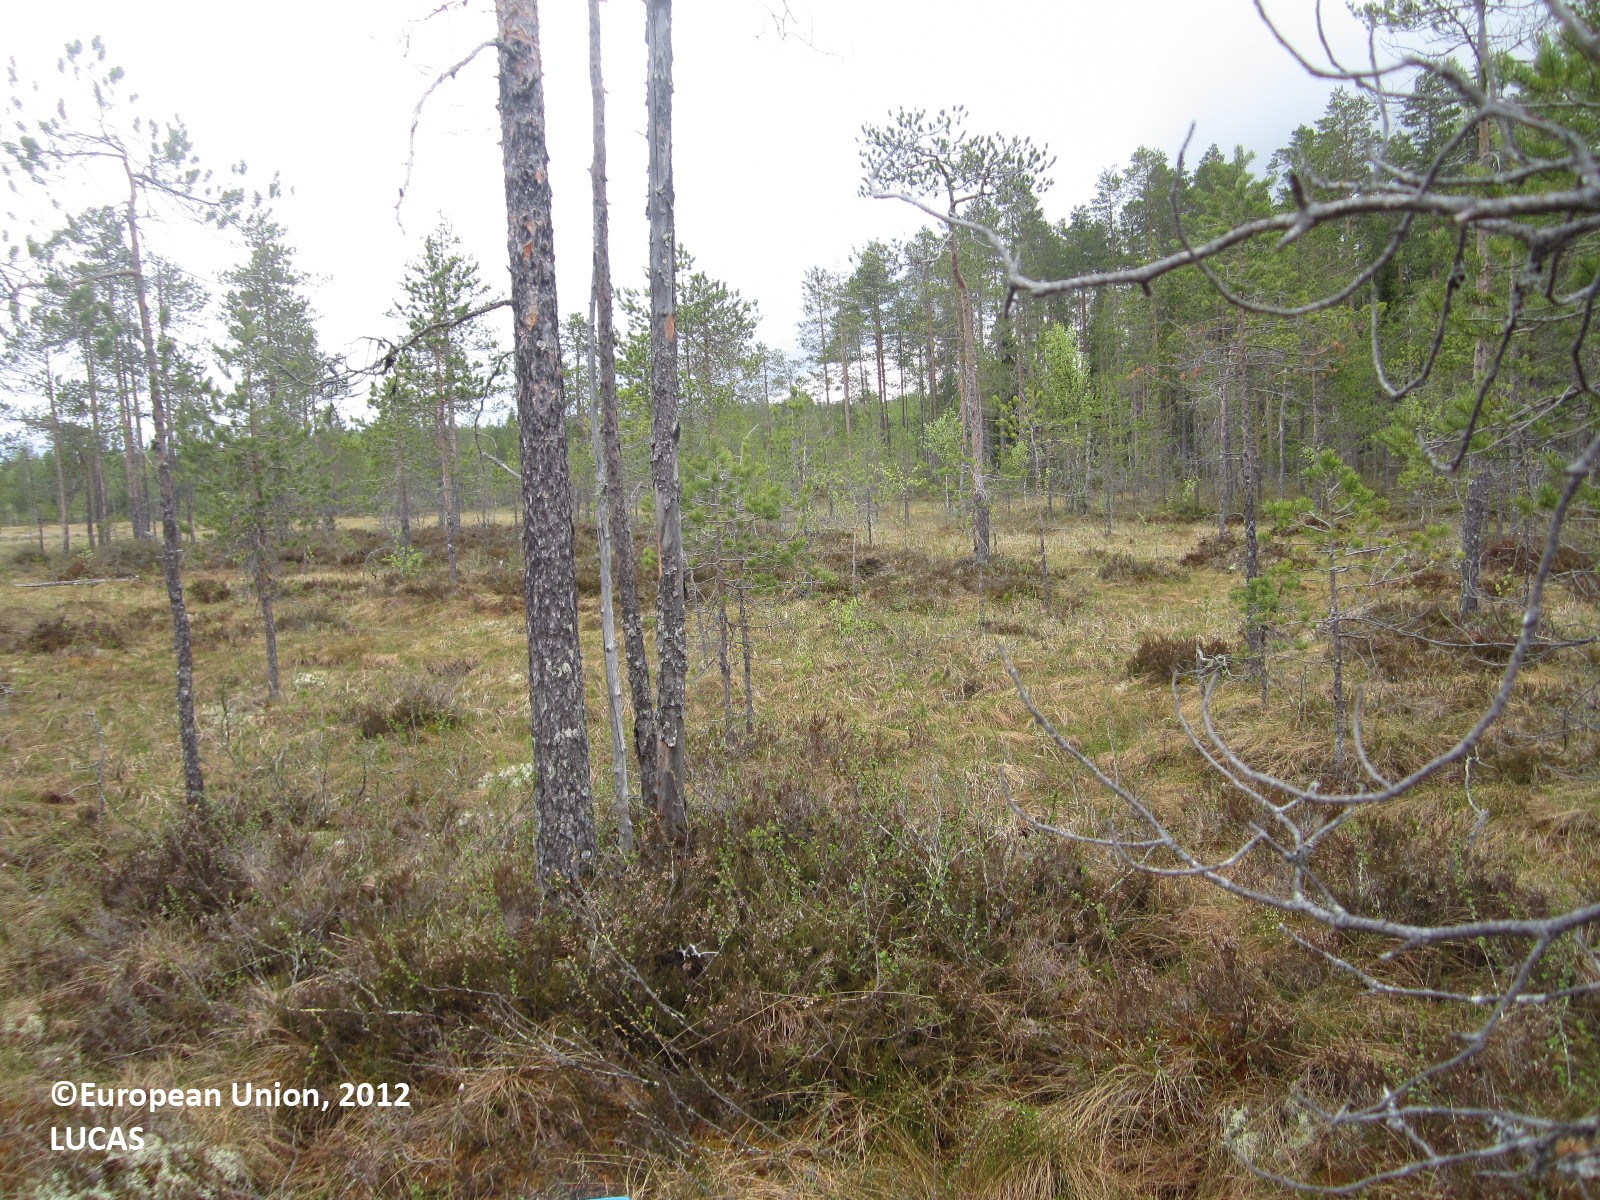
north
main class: Woodland
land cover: Pine dominated coniferous woodland
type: mire and swamp forests
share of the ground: 10 - 25 %
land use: Semi-natural and natural areas not in use
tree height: > 5 m
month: June
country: FI
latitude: 64.6834
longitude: 28.6000
